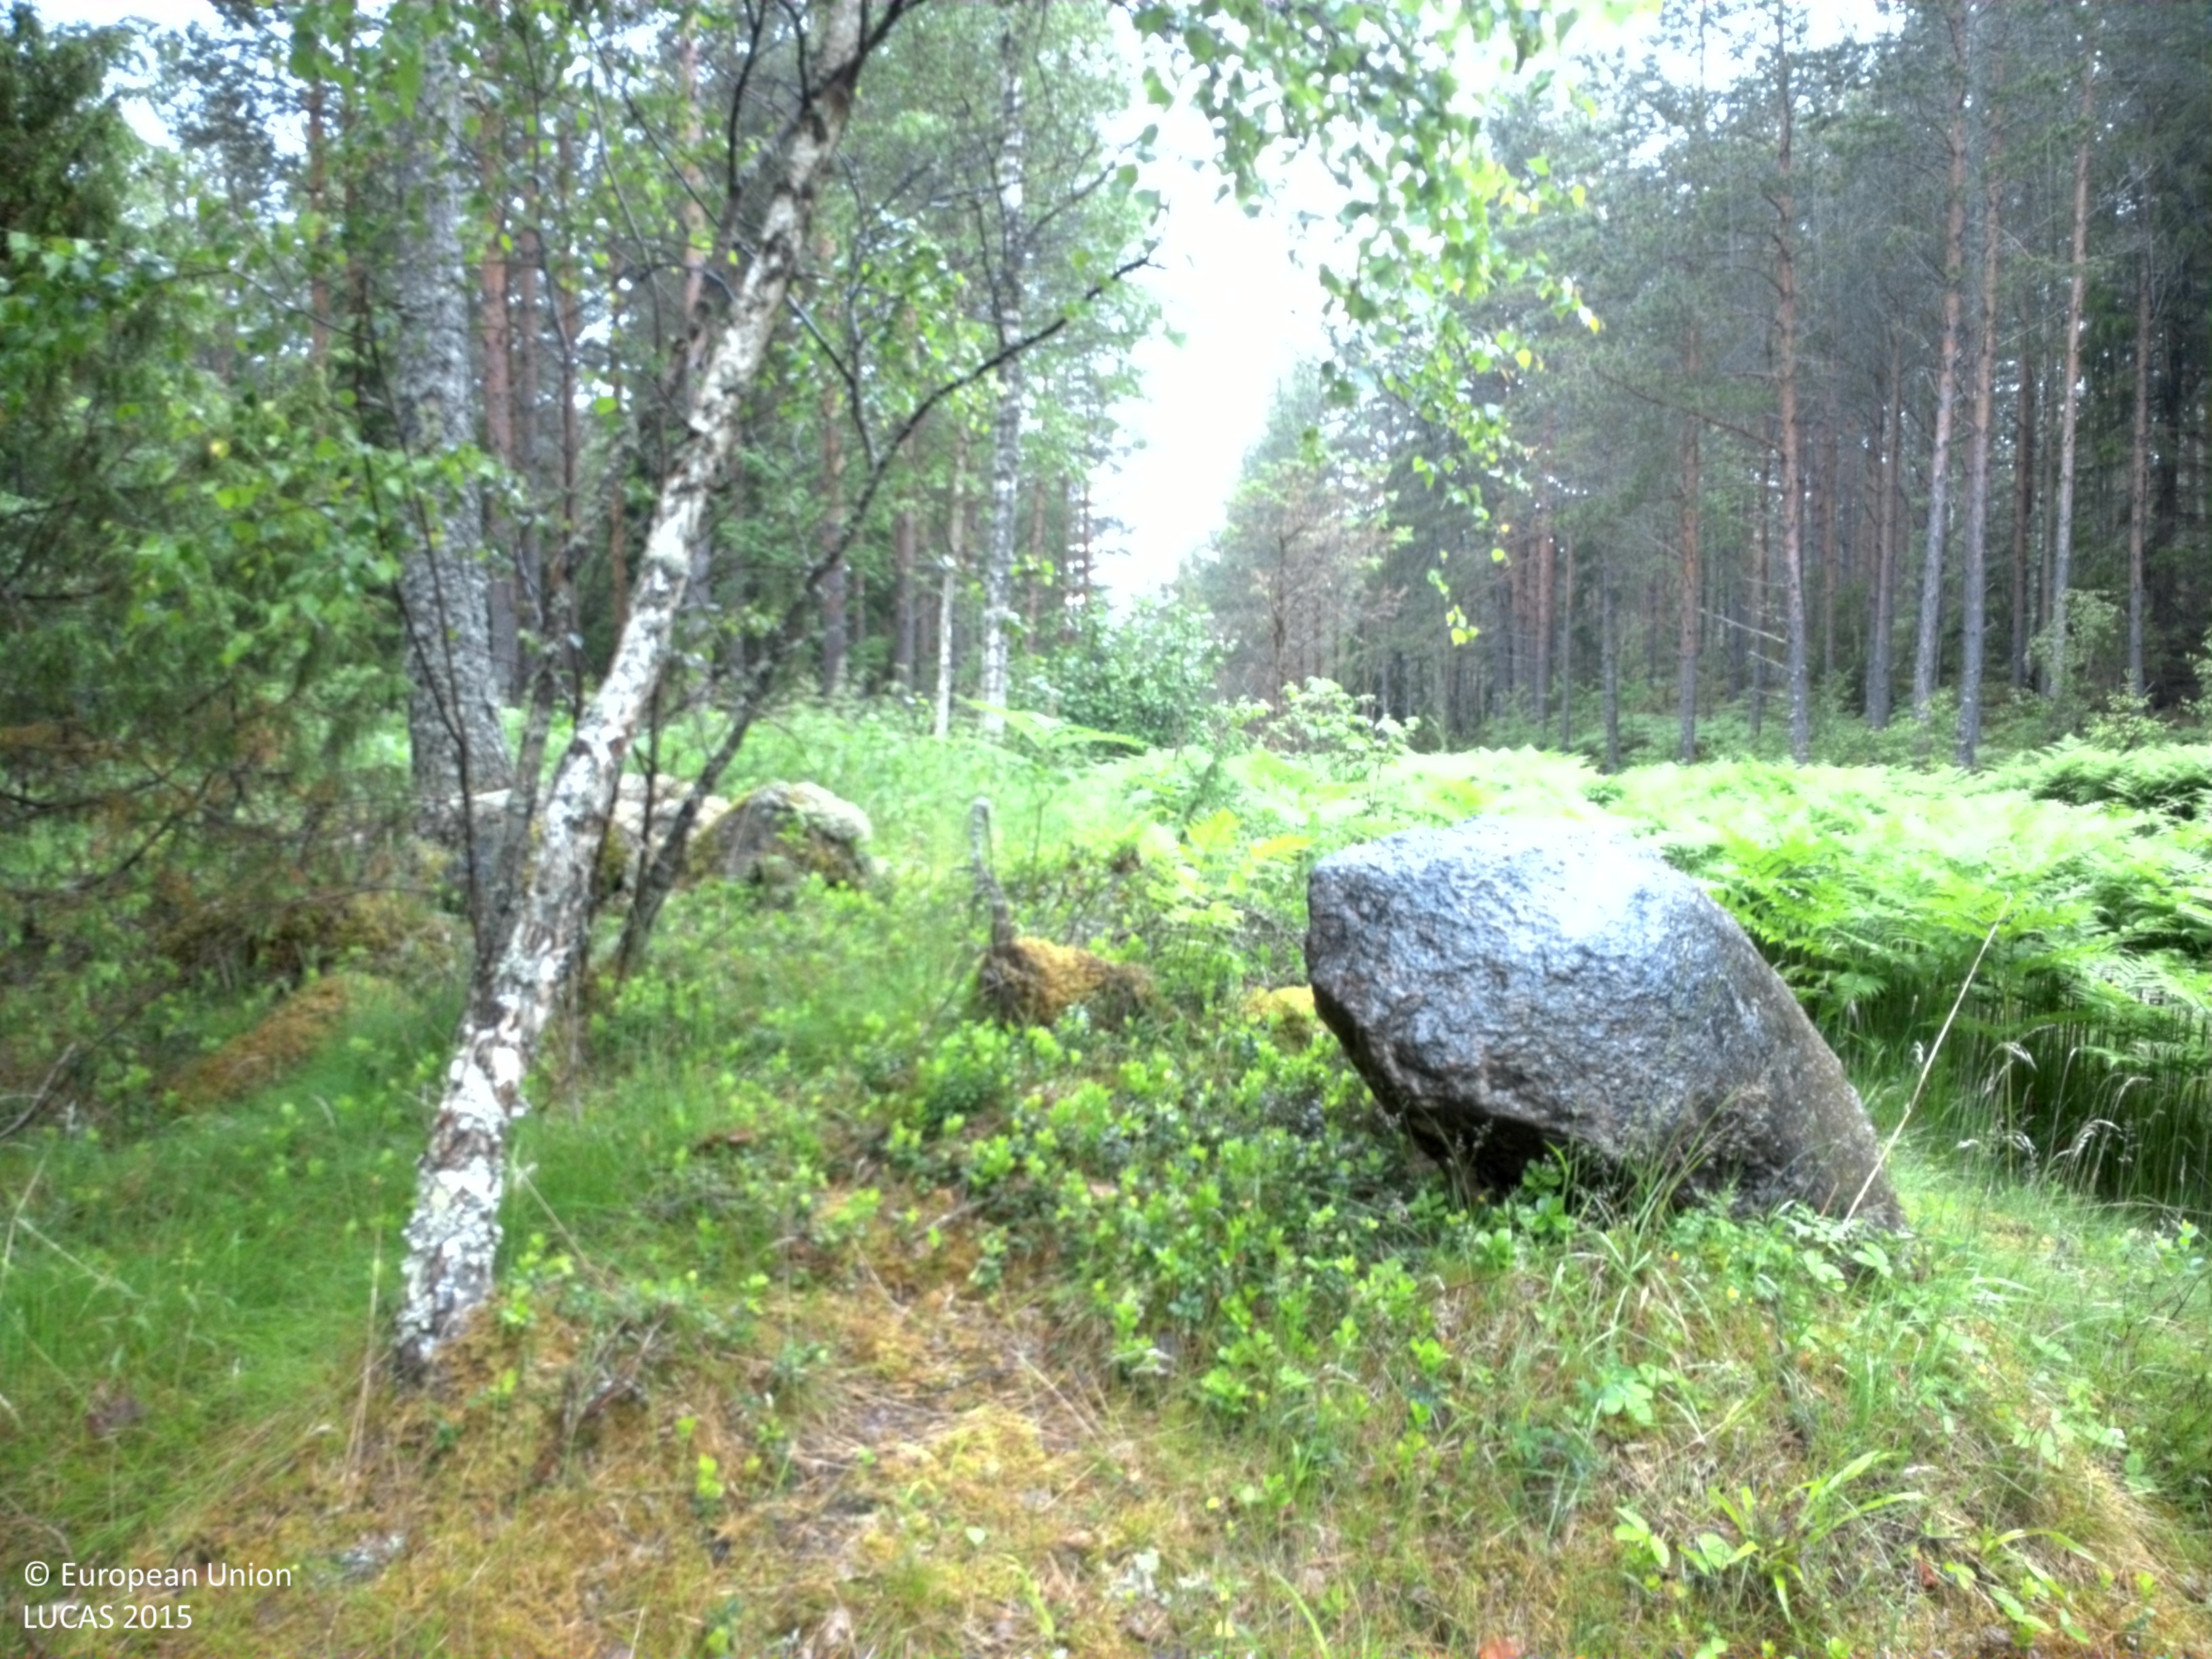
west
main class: Woodland
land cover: Pine dominated mixed woodland
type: boreal forest
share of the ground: 25 - 50 %
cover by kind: herbaceous plants 45 %, coniferous forest trees 30 %, broadleaved forest trees 15 %, lichens and mosses 10 %
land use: Forestry
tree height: > 5 m
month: June
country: SE
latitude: 58.6677
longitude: 15.4592
